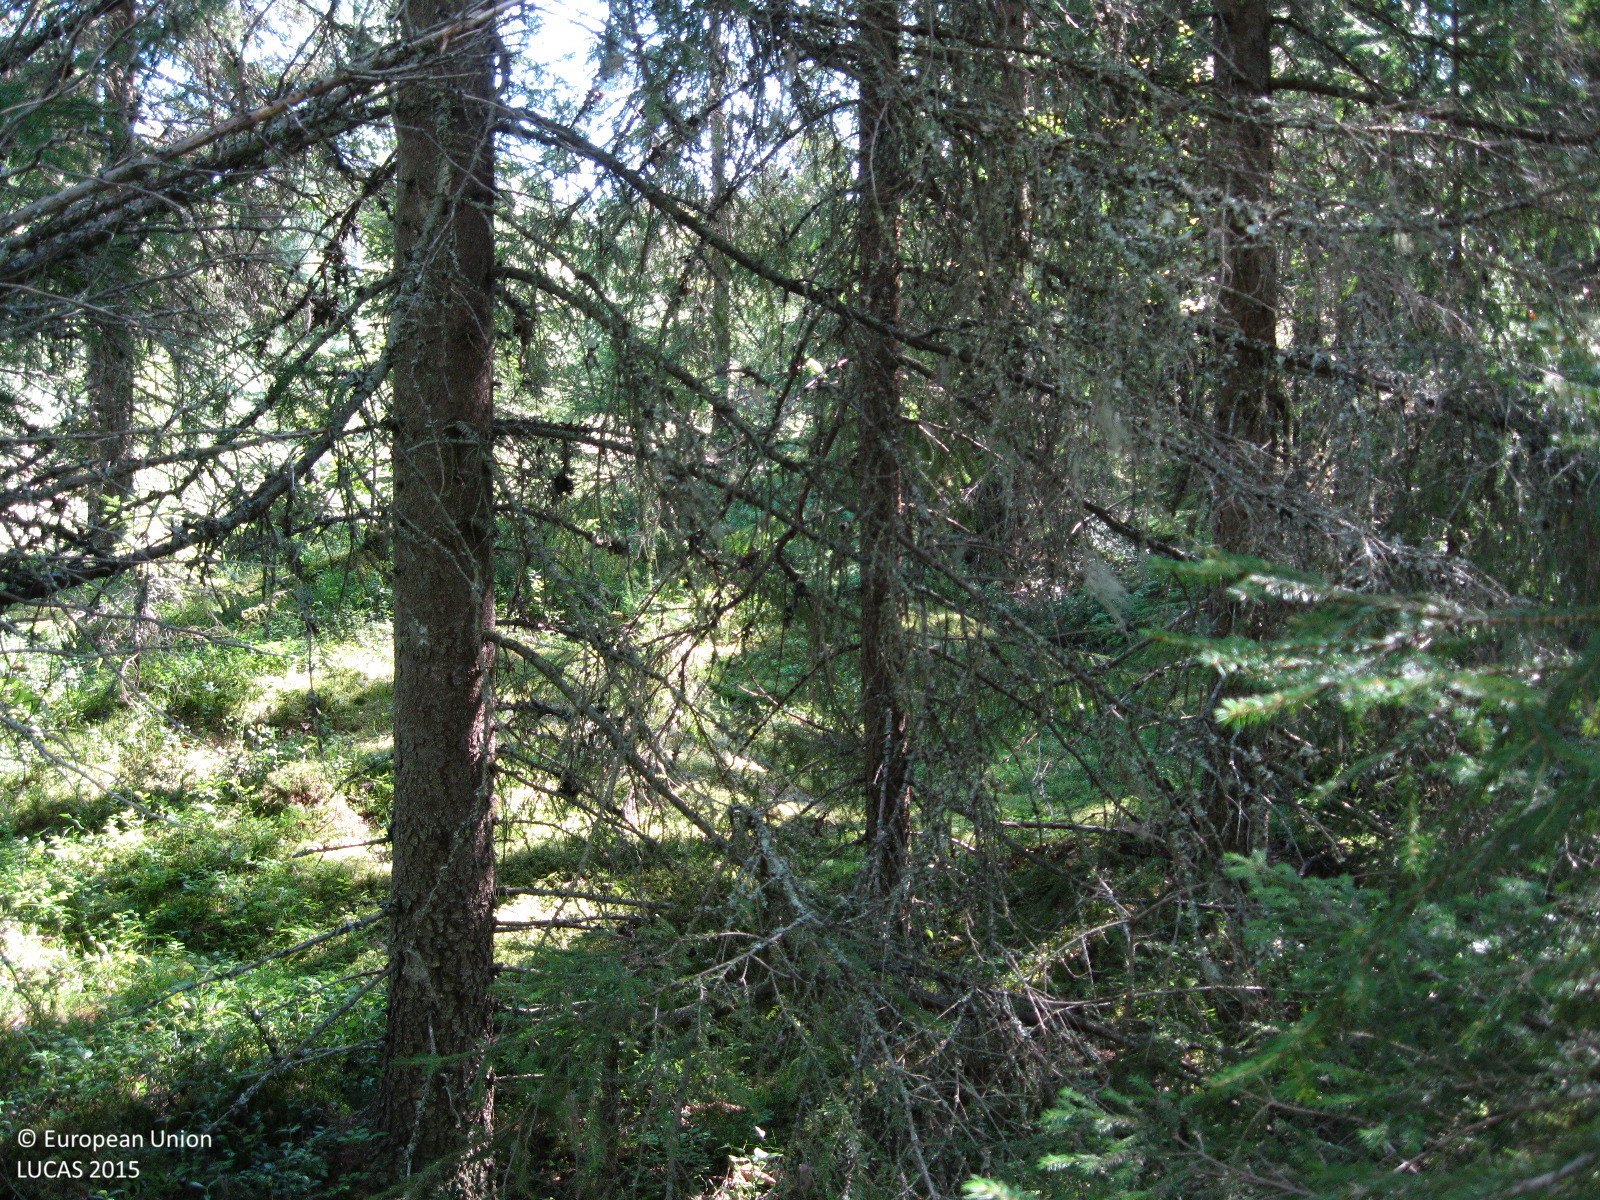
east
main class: Woodland
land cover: Other coniferous woodland
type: boreal forest
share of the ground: 50 - 75 %
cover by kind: coniferous forest trees 50 %, lichens and mosses 25 %, shrubs 15 %, broadleaved forest trees 10 %
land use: Forestry
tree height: > 5 m
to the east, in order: Other coniferous woodland; Pine dominated mixed woodland; Spruce dominated coniferous woodland; Other coniferous woodland
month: August
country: FI
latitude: 61.4535
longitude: 25.1387
